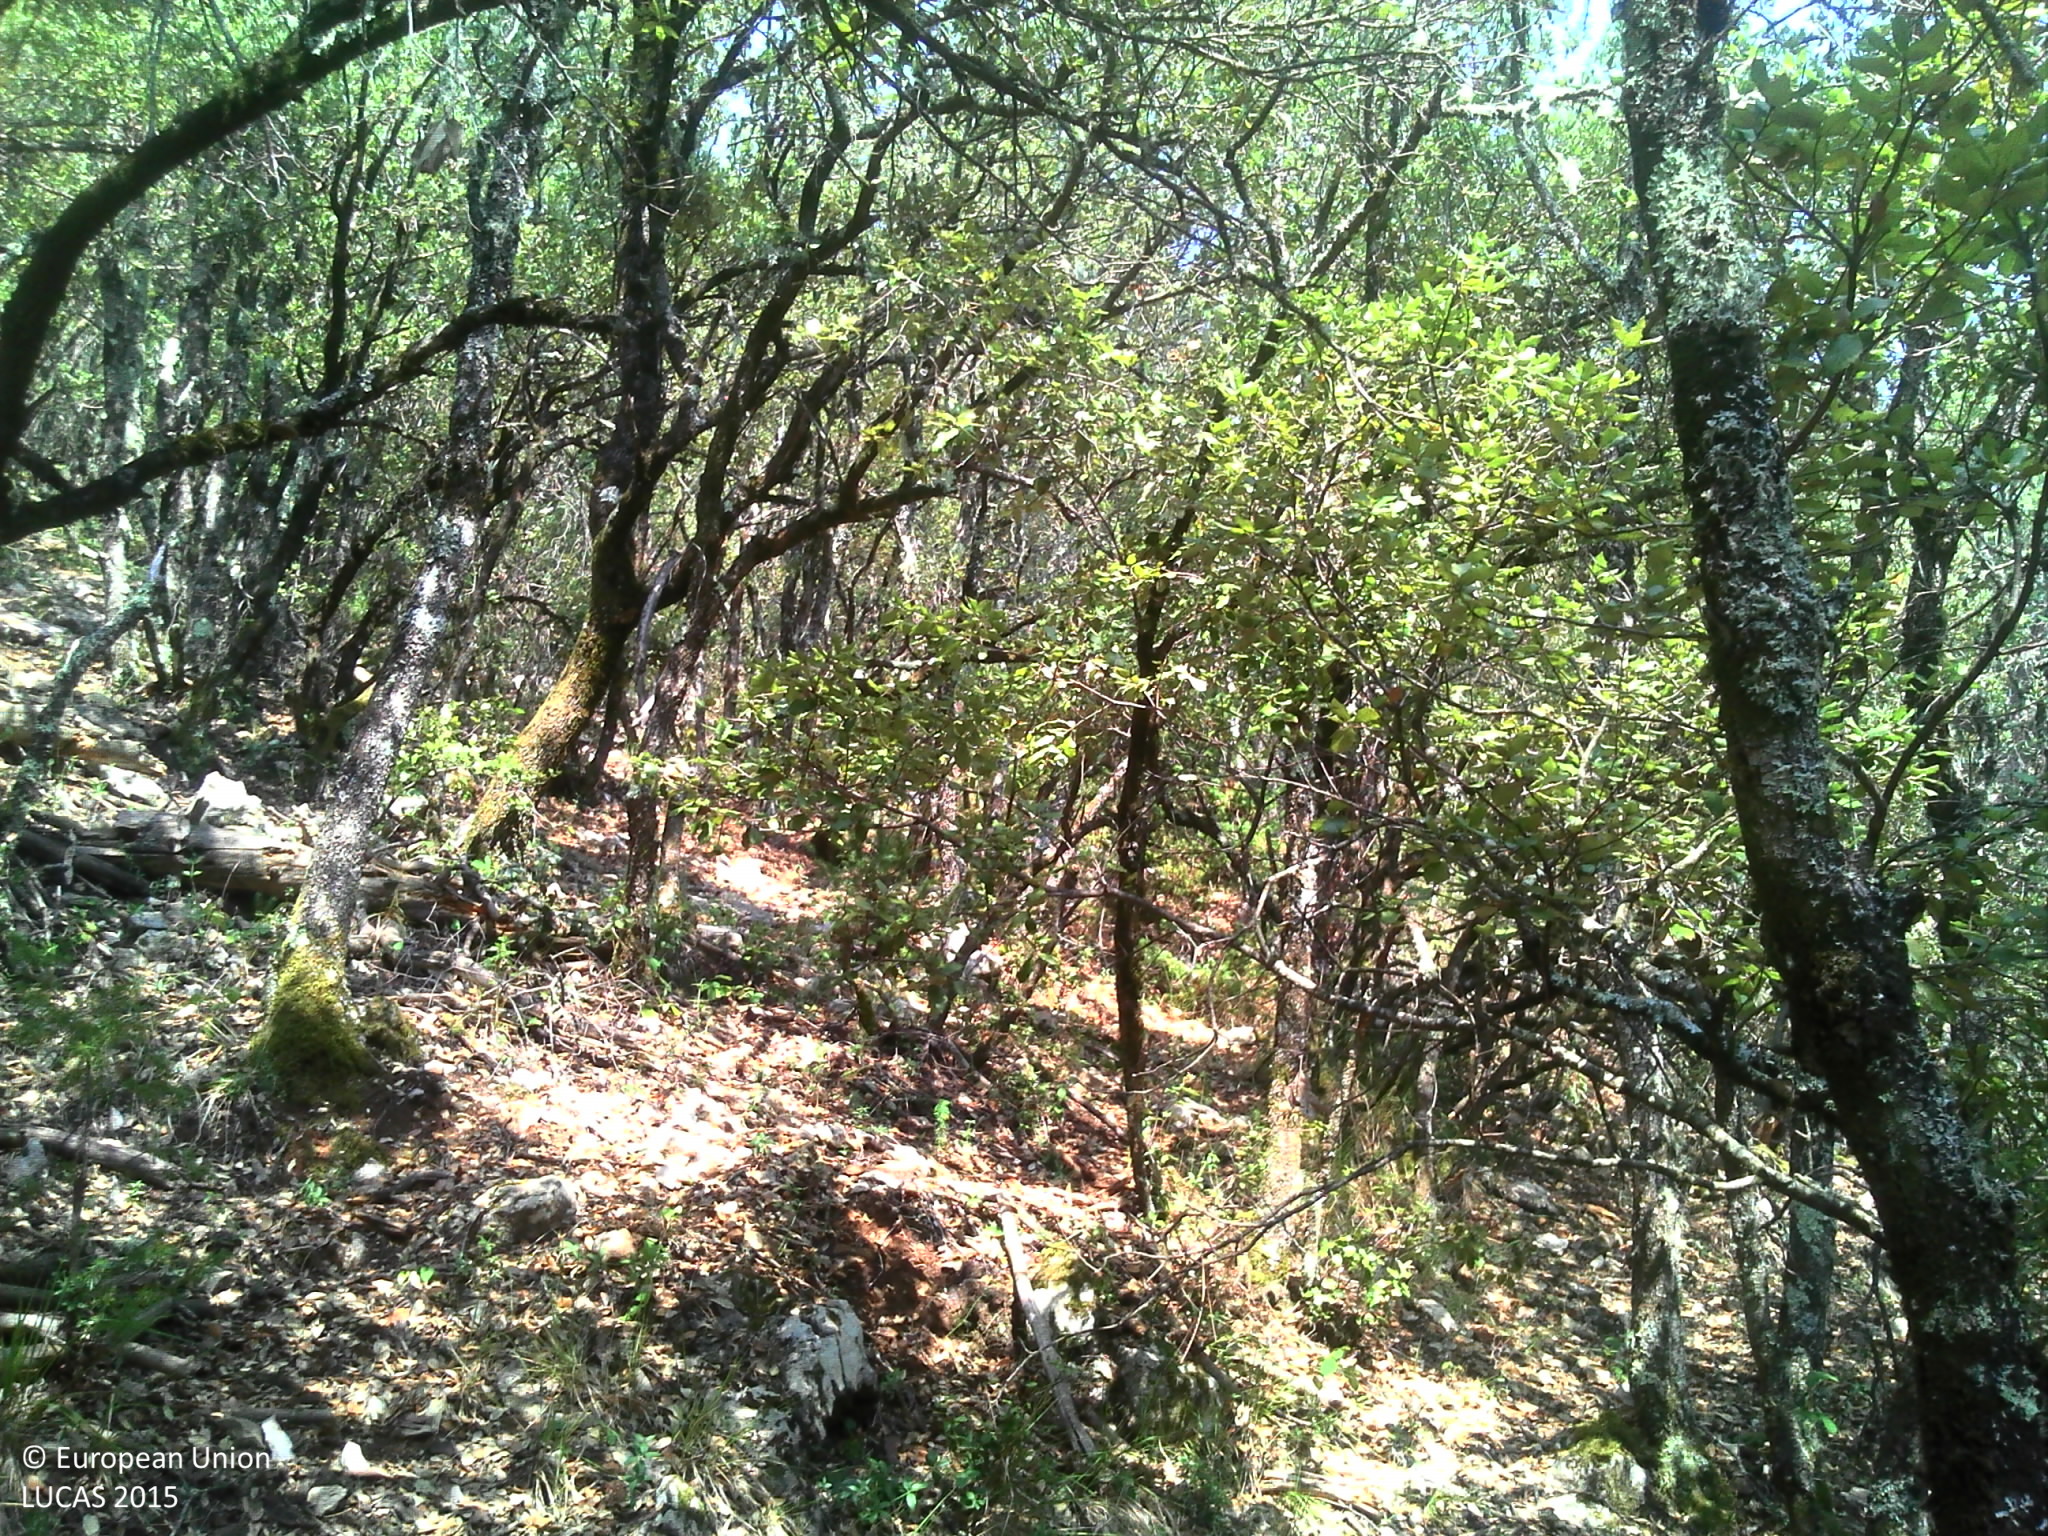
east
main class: Woodland
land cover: Broadleaved woodland
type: thermophilous deciduous forest
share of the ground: > 75 %
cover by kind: broadleaved forest trees 90 %, unconsolidated bare surface 10 %
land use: Semi-natural and natural areas not in use
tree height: > 5 m
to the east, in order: Broadleaved woodland; Rock outcrops; Broadleaved woodland
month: August
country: FR
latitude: 43.6355
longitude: 6.3270
